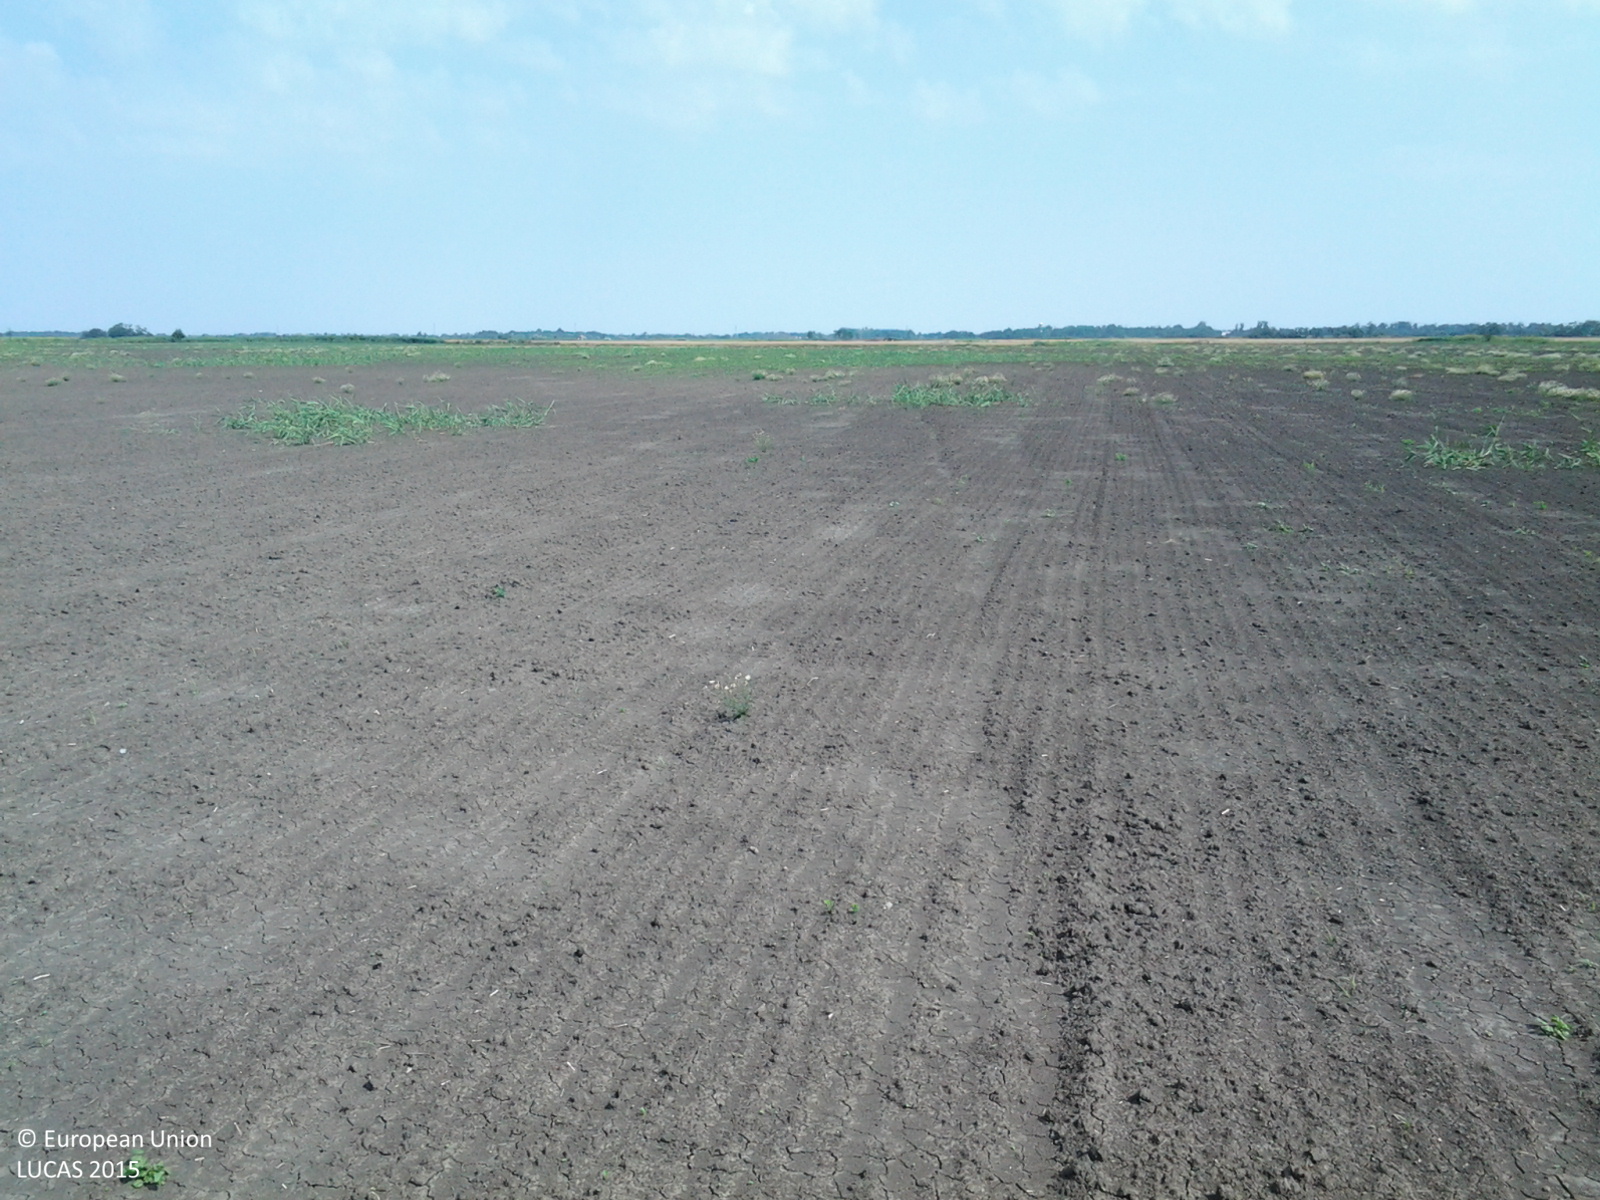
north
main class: Cropland
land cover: Maize
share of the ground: < 10 %
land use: Agriculture (excluding fallow land and kitchen gardens)
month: July
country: HU
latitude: 46.9812
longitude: 20.4535
